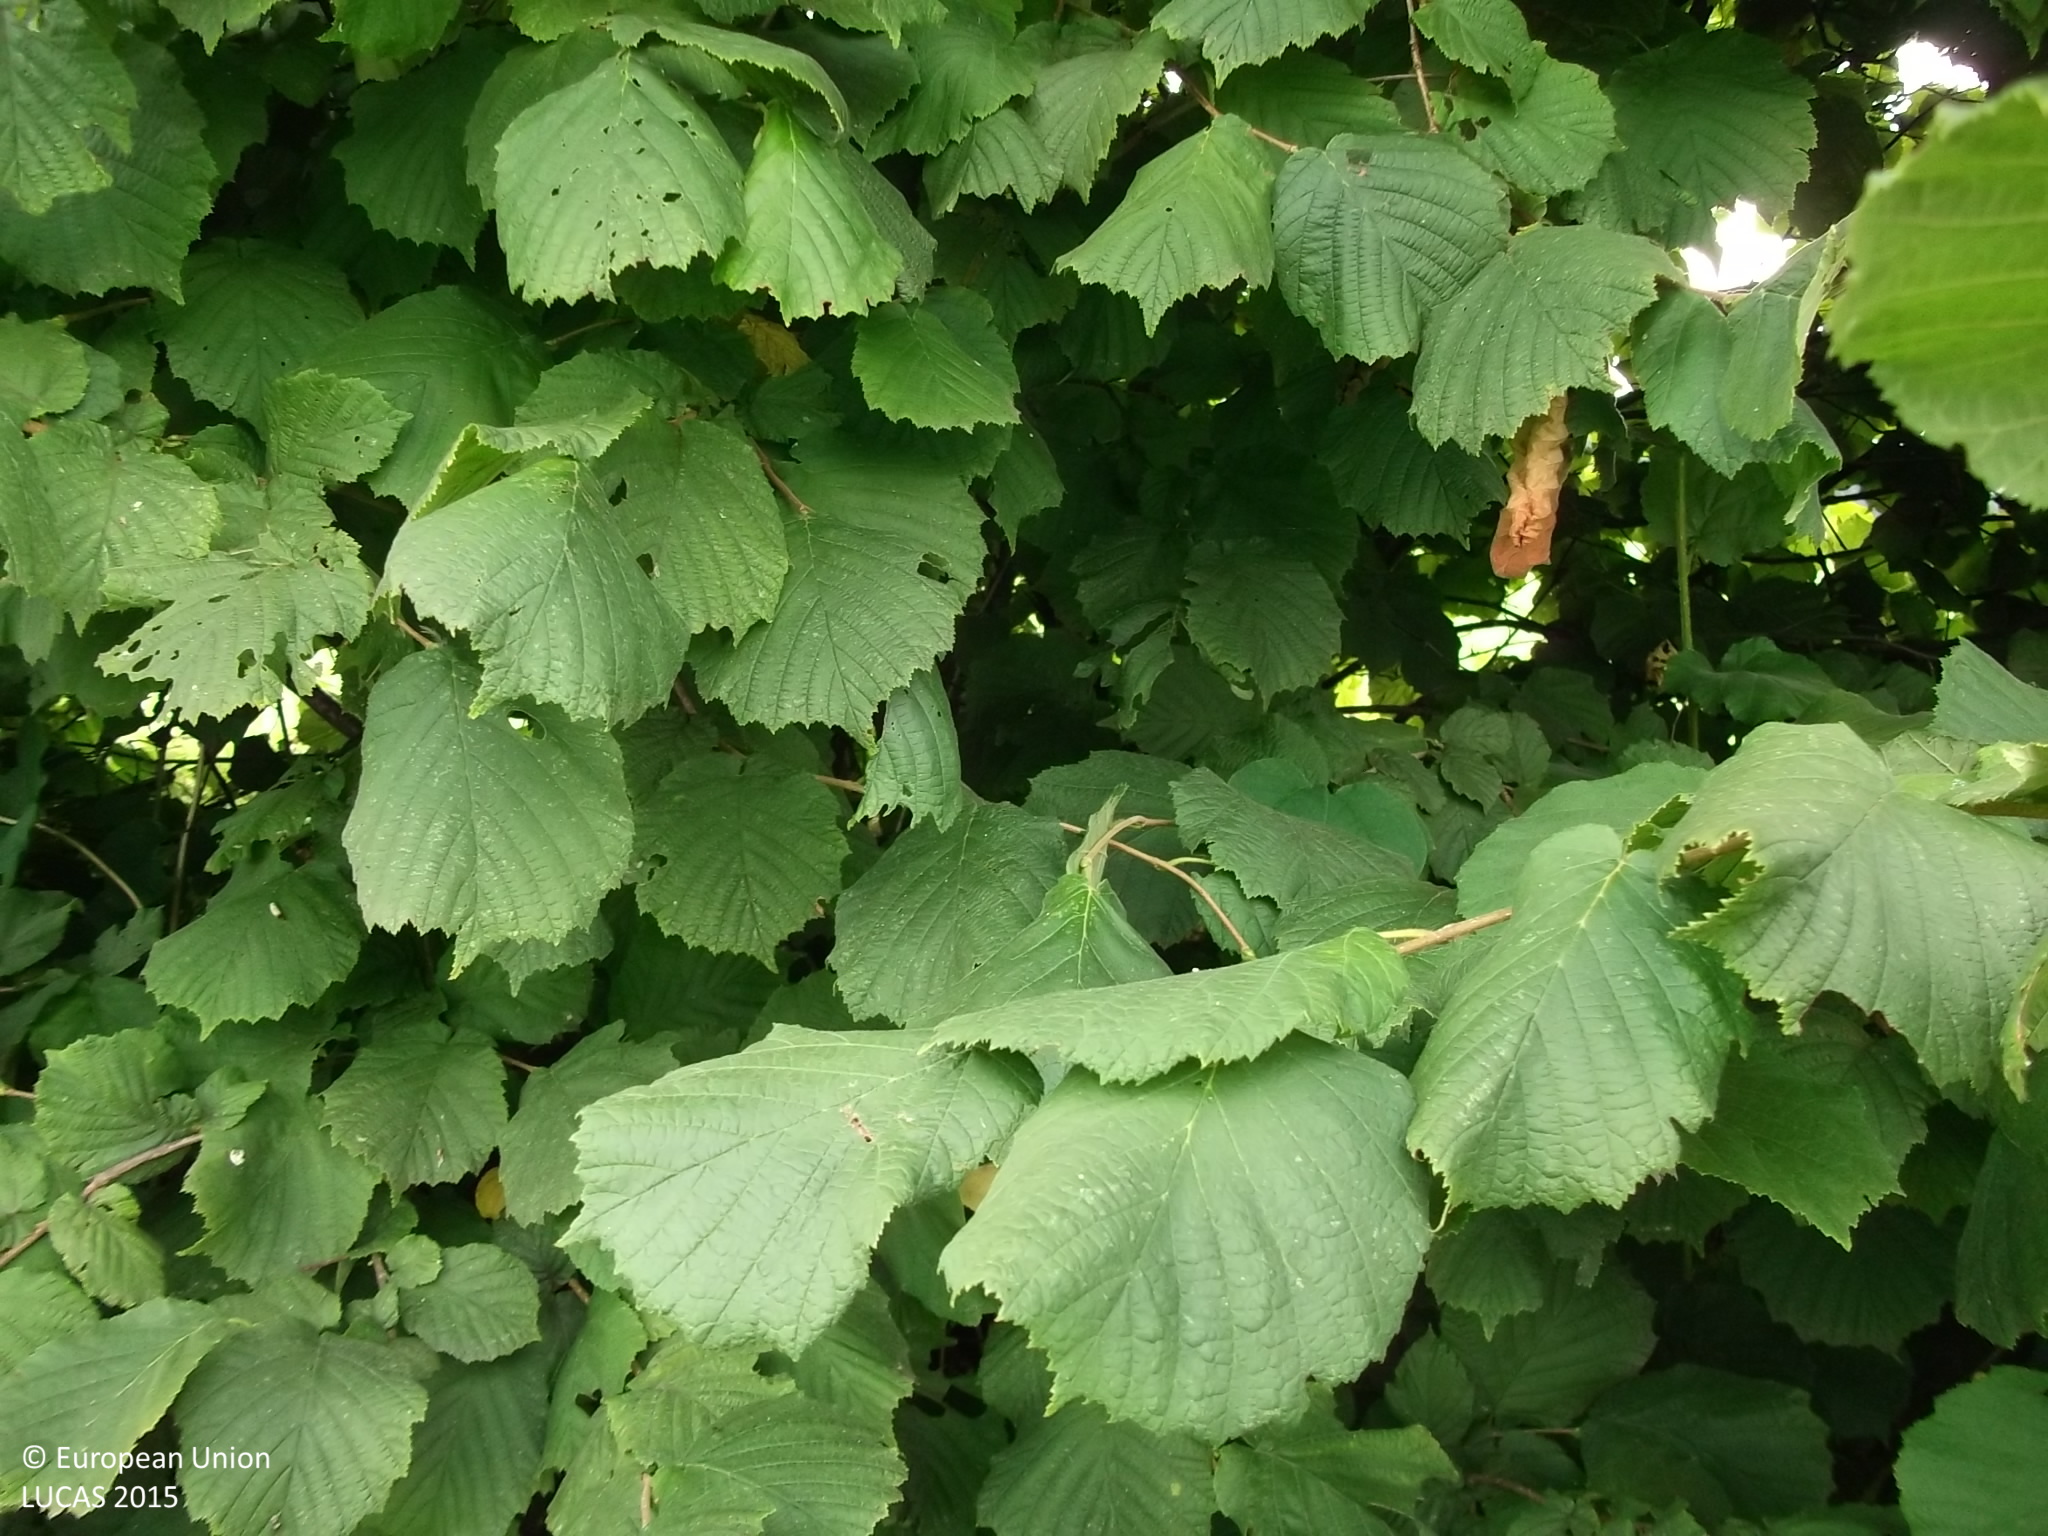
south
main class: Grassland
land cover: Grassland without tree/shrub cover
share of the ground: > 75 %
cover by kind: herbaceous plants 95 %, shrubs 5 %
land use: Agriculture (excluding fallow land and kitchen gardens)
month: August
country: AT
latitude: 47.9554
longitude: 13.3869
